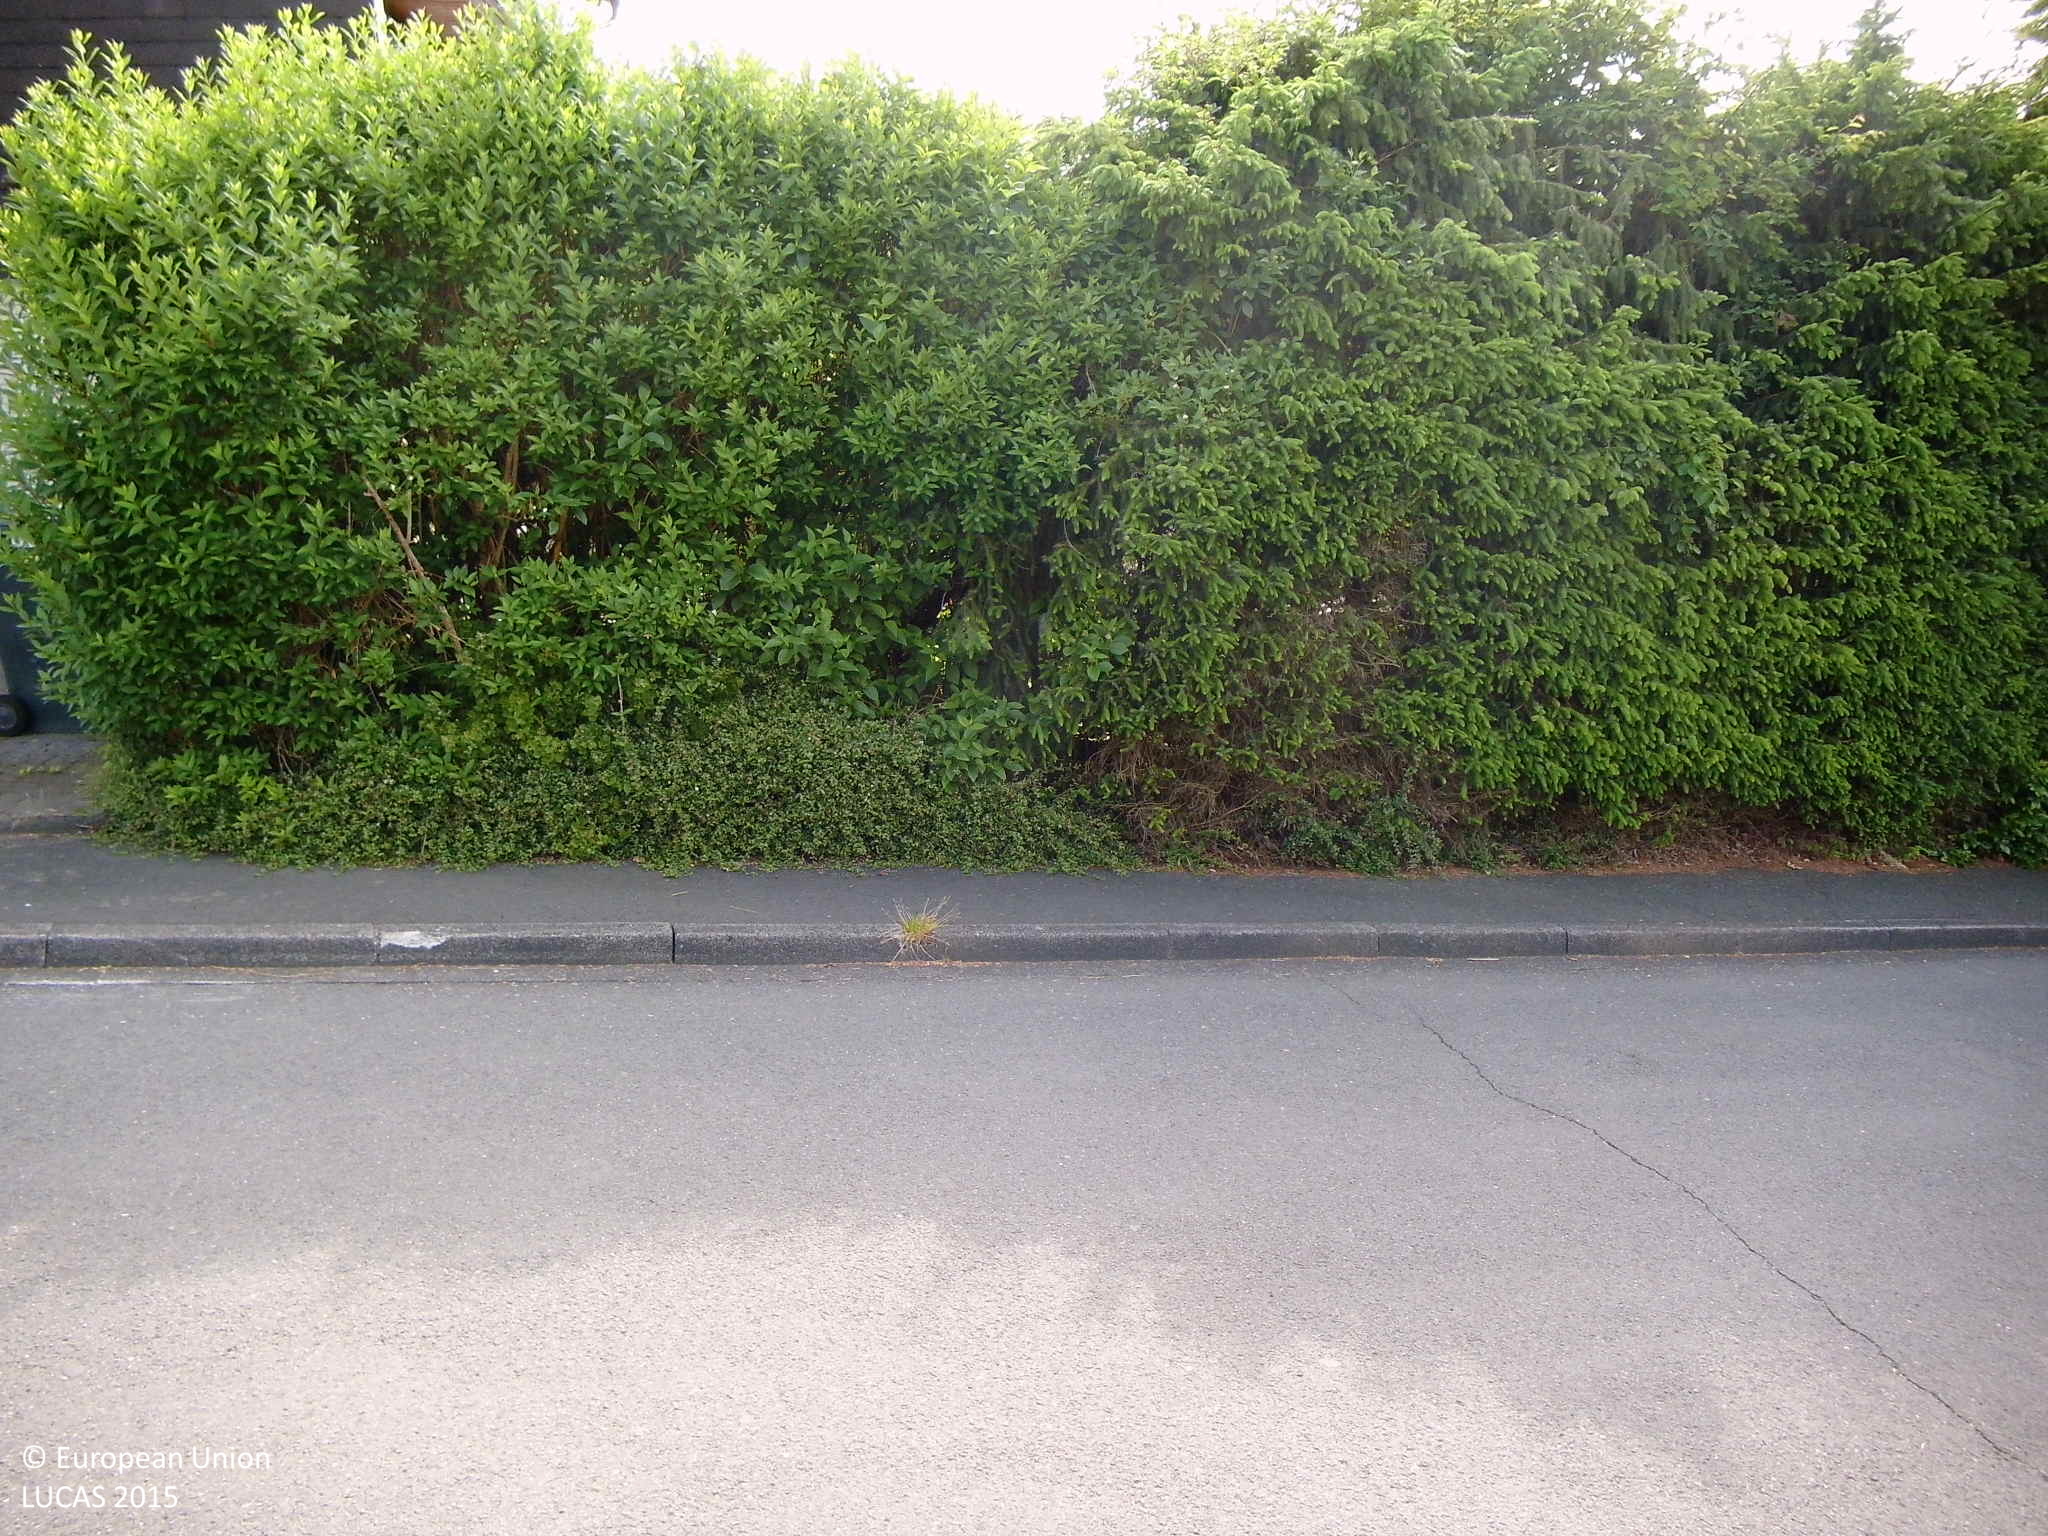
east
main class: Woodland
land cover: Broadleaved woodland
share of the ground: 25 - 50 %
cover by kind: herbaceous plants 55 %, broadleaved forest trees 40 %, shrubs 5 %
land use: Residential
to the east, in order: Broadleaved woodland; Artificial constructions in urban areas; Grassland without tree/shrub cover; Electric lines; Grassland without tree/shrub cover; Fences; Grassland without tree/shrub cover
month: June
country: DE
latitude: 50.9774
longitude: 8.0776
